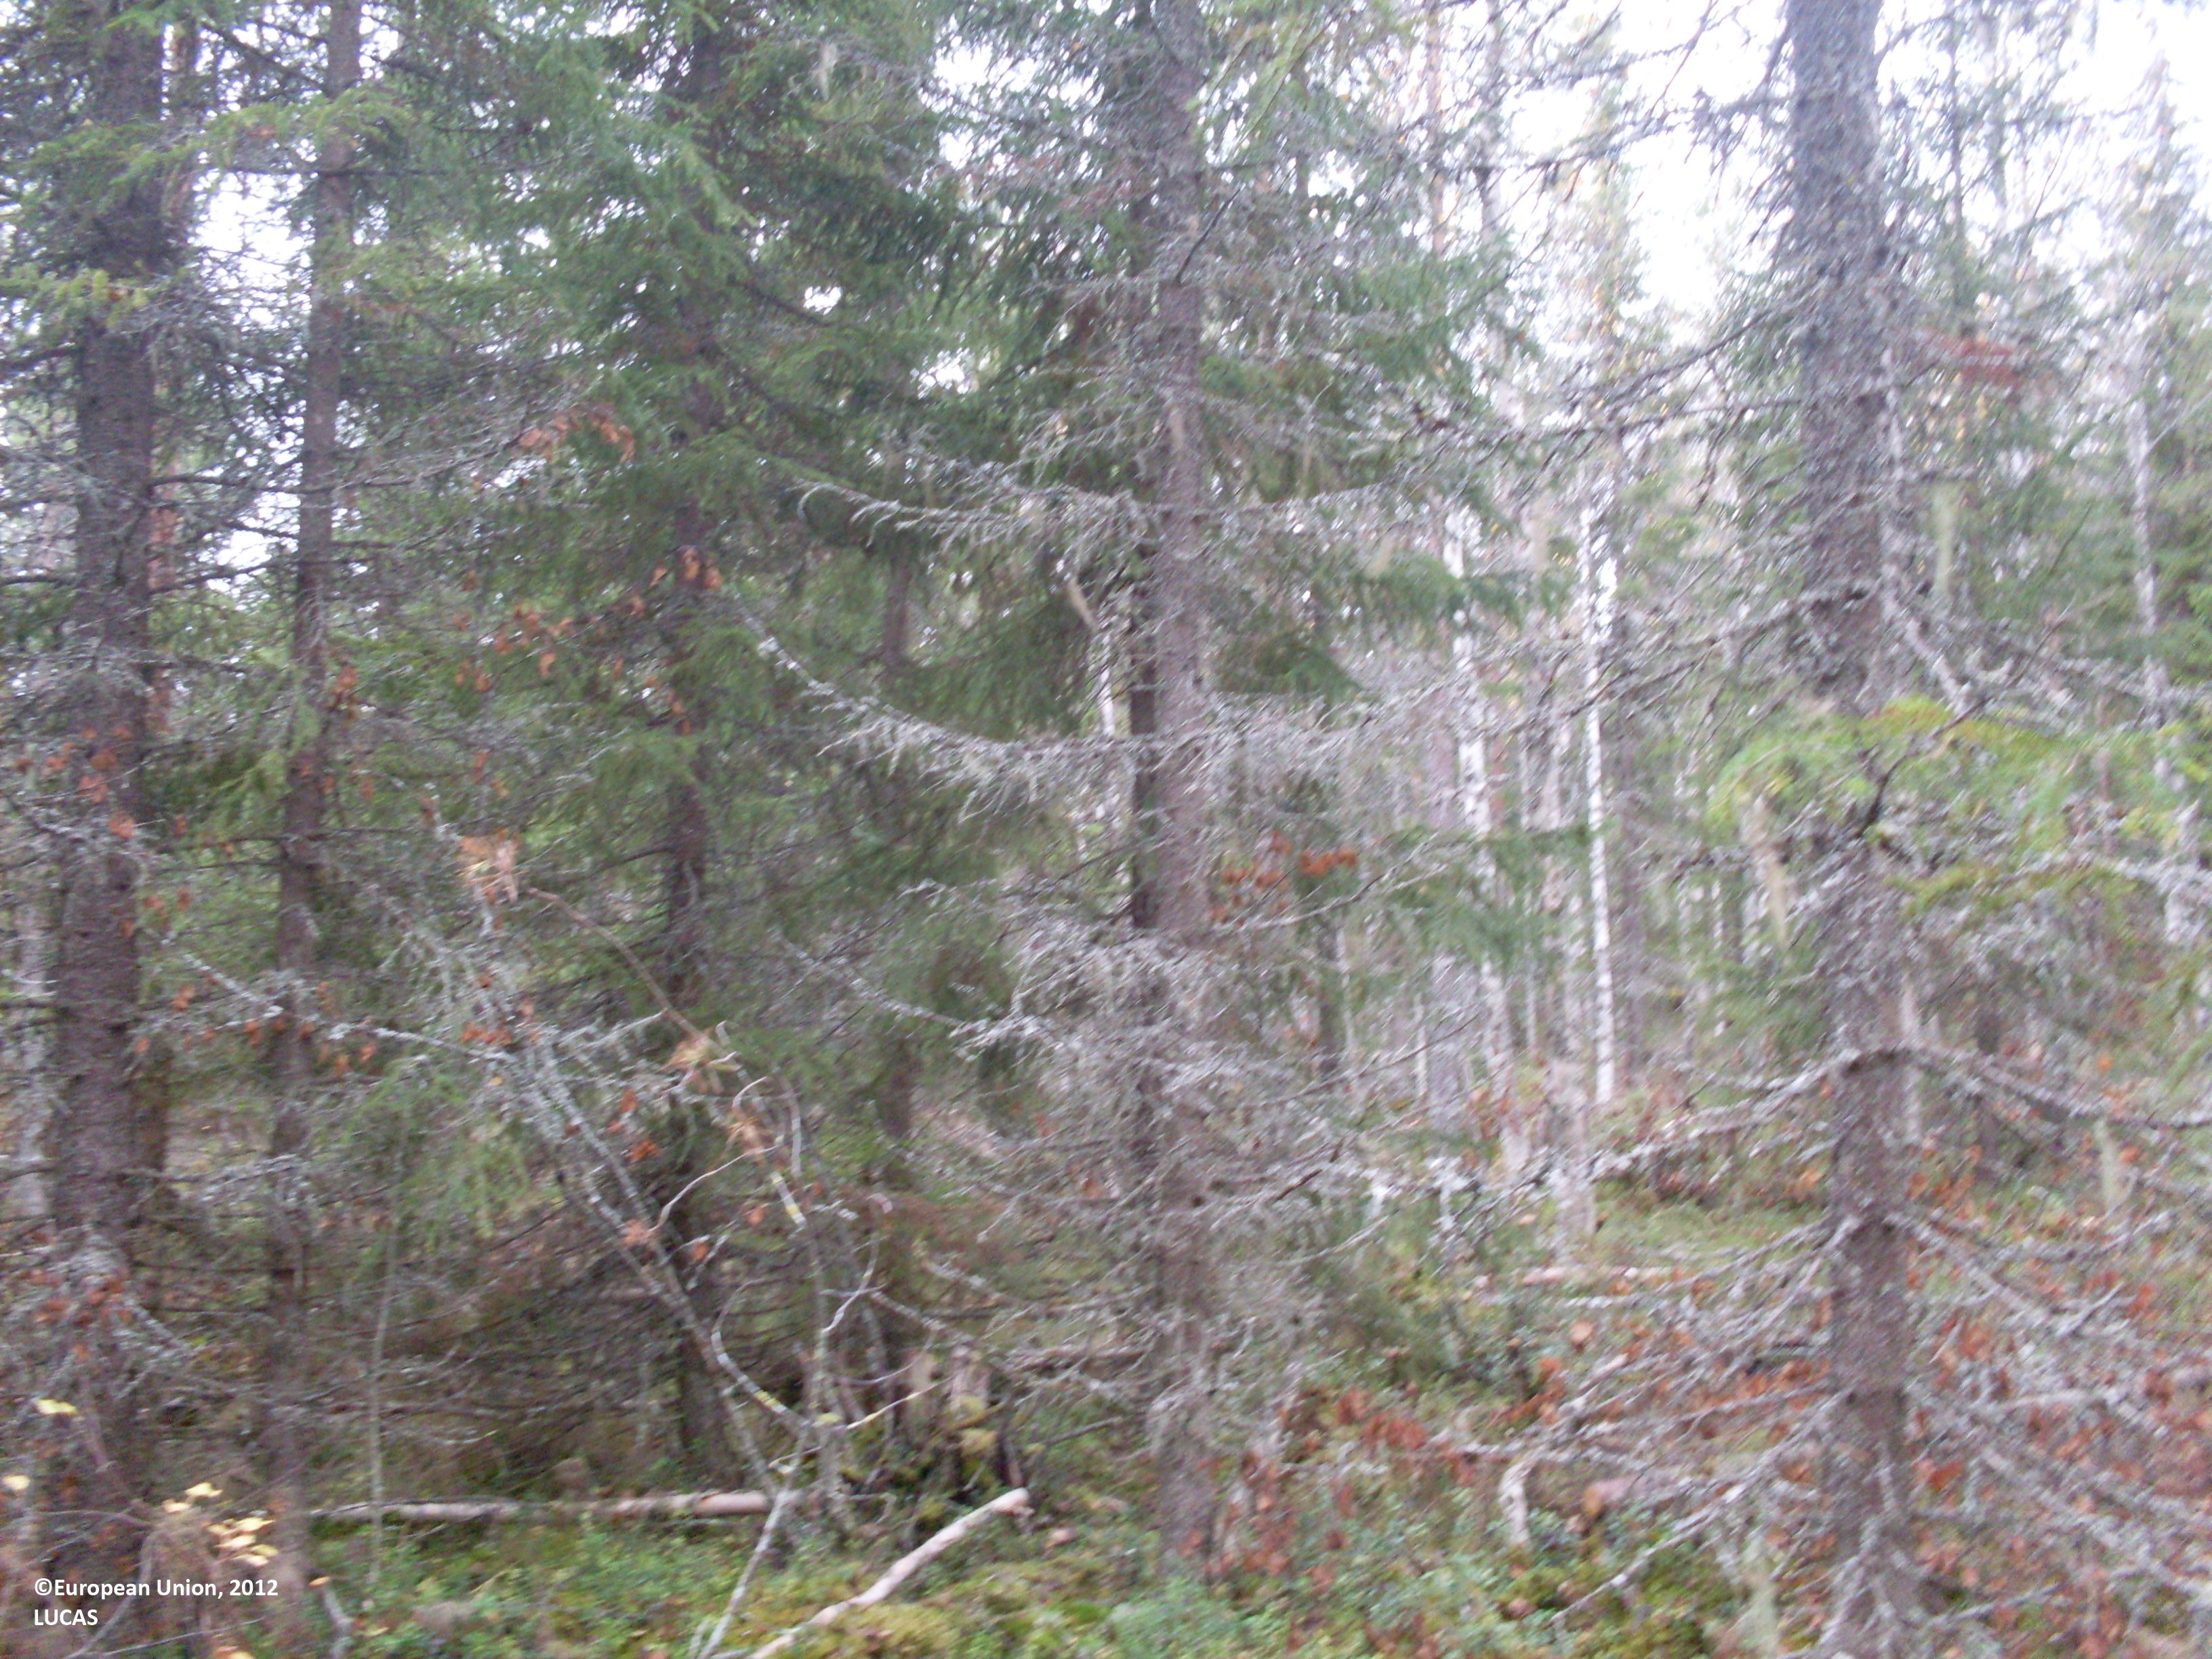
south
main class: Woodland
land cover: Spruce dominated mixed woodland
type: boreal forest
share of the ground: > 75 %
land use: Forestry
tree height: > 5 m
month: September
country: FI
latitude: 64.6767
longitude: 28.8127
